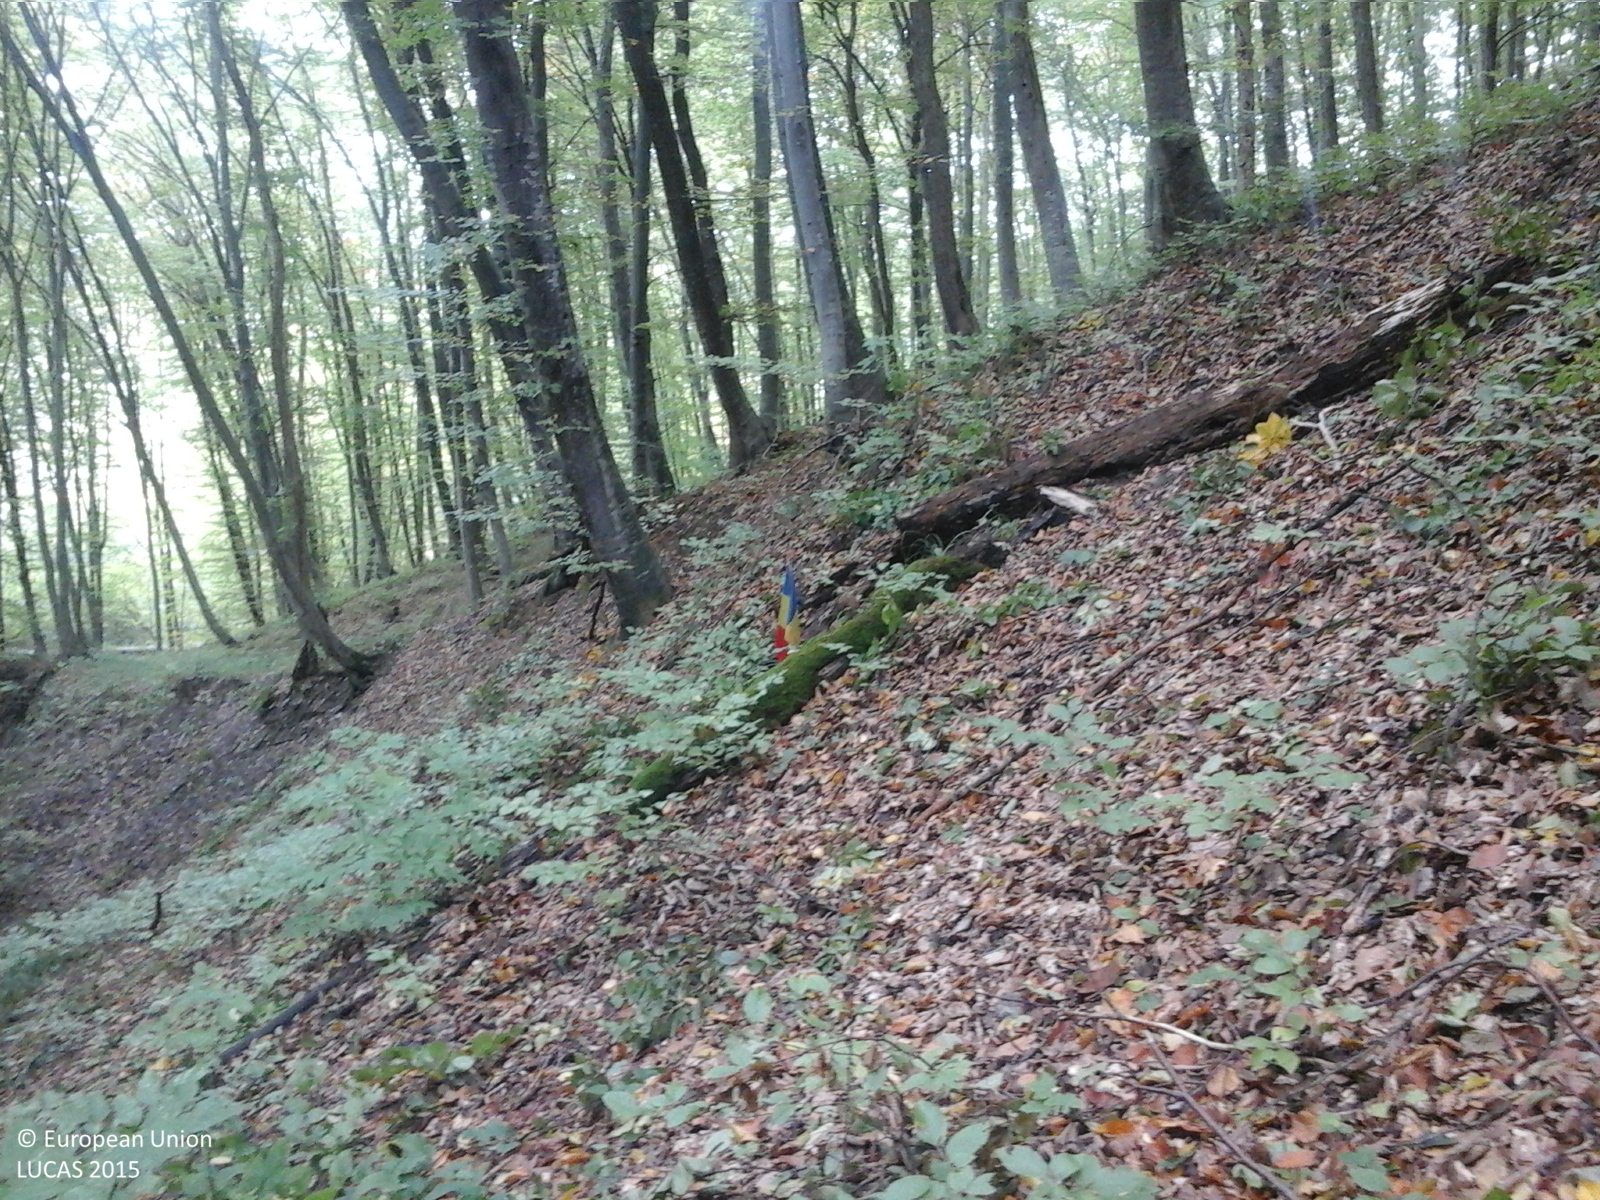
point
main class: Woodland
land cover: Broadleaved woodland
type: beech forest
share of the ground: > 75 %
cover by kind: broadleaved forest trees 100 %
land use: Forestry
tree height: > 5 m
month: October
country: RO
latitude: 46.2664
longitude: 25.0570
